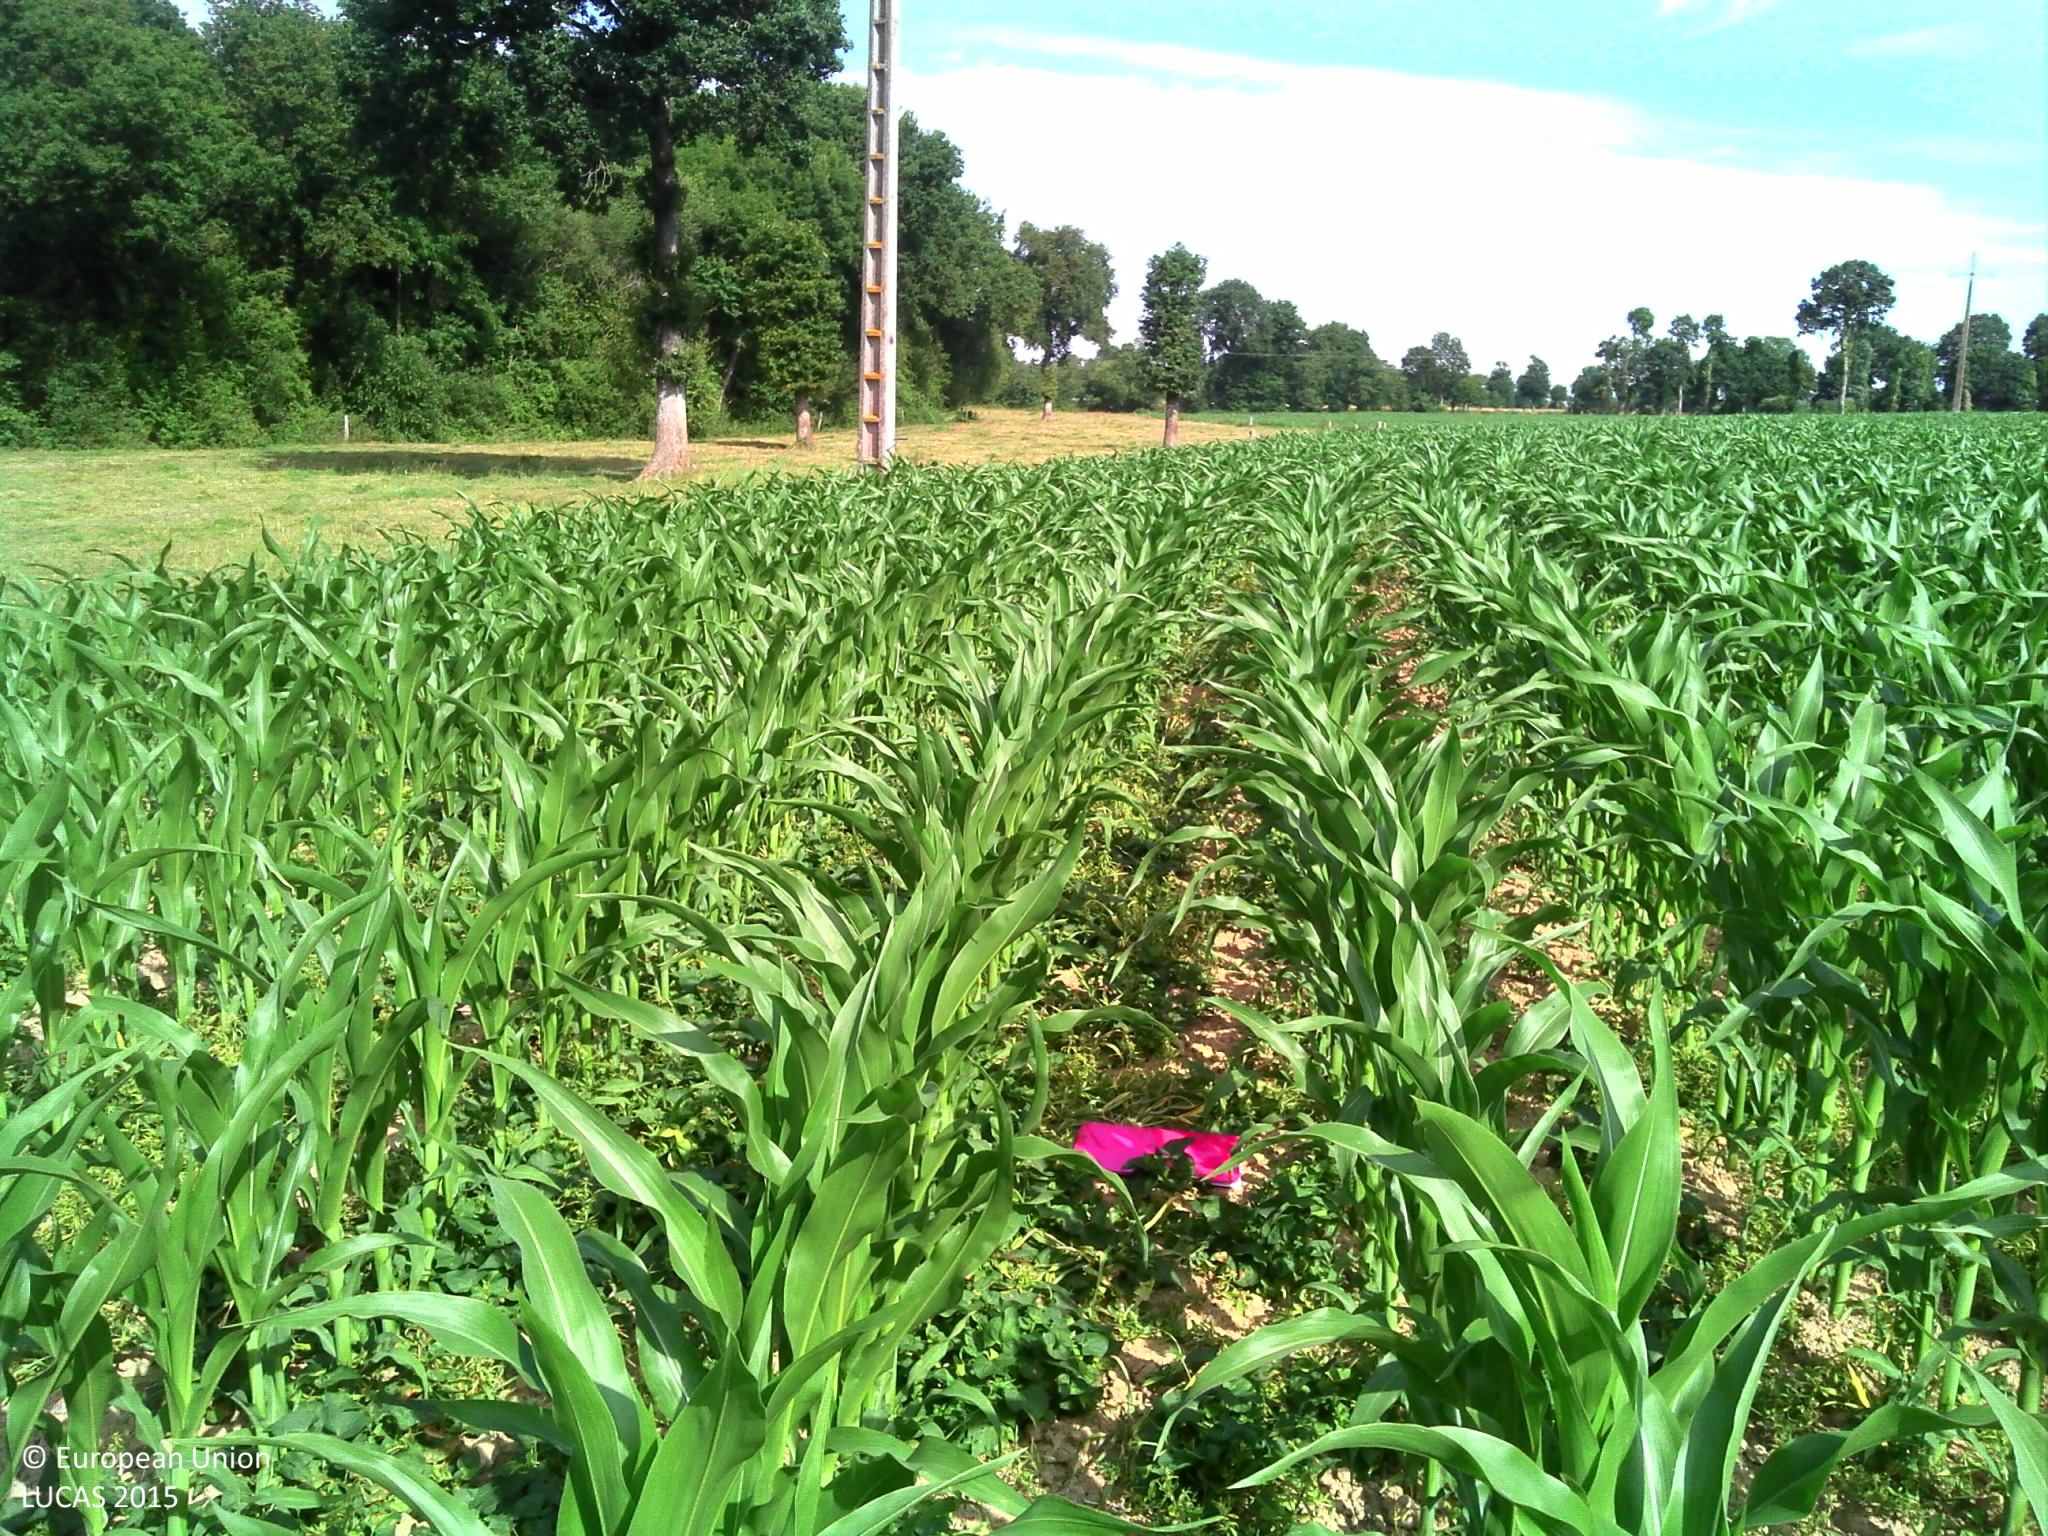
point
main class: Cropland
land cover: Maize
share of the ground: > 75 %
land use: Agriculture (excluding fallow land and kitchen gardens)
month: June
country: FR
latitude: 47.9612
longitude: -2.0388
